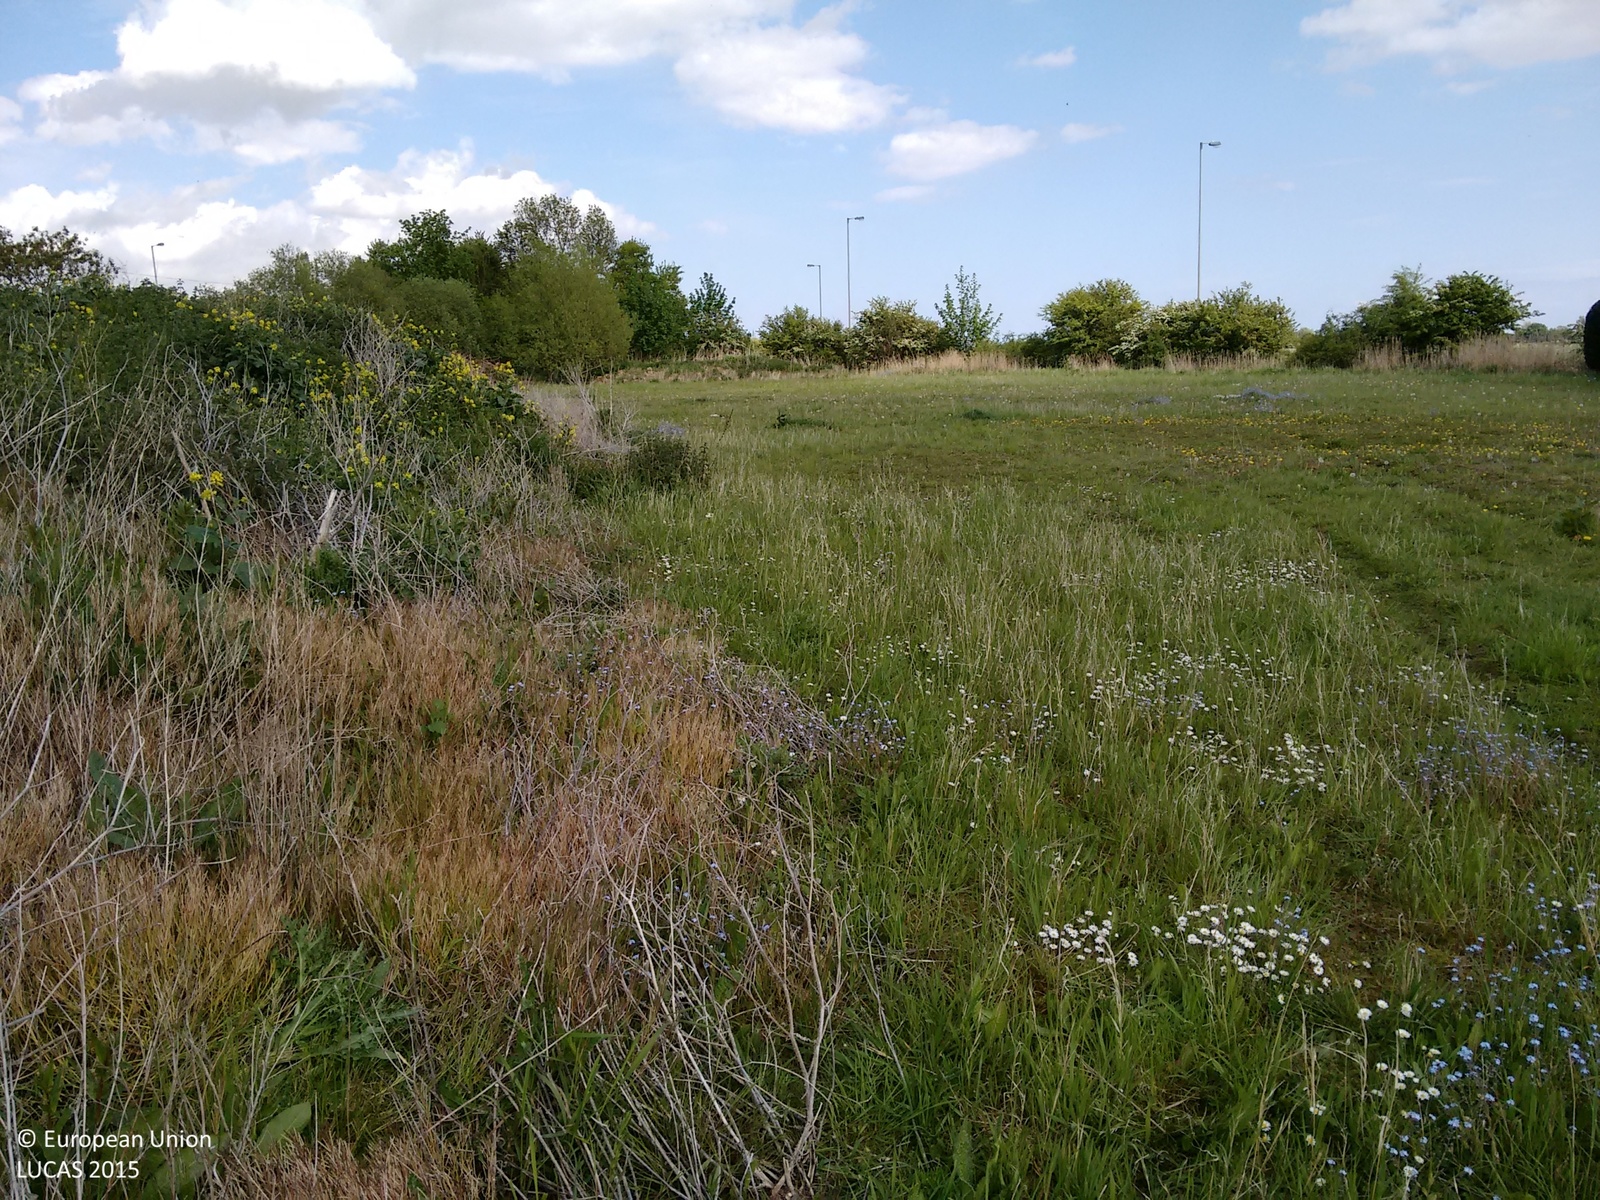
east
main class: Grassland
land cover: Grassland without tree/shrub cover
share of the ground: > 75 %
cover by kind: herbaceous plants 100 %
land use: Agriculture (excluding fallow land and kitchen gardens)
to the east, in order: Grassland without tree/shrub cover; Ditches and canals; Abandoned hedges; Grass margins; Paved roads, cycling and walking lanes; Grass margins; Ditches and canals; Grass margins; Common wheat; Grass margins; Tracks; Grassland without tree/shrub cover; Other bare soil; Grassland without tree/shrub cover
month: May
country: GB
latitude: 52.9570
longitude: -0.1412
